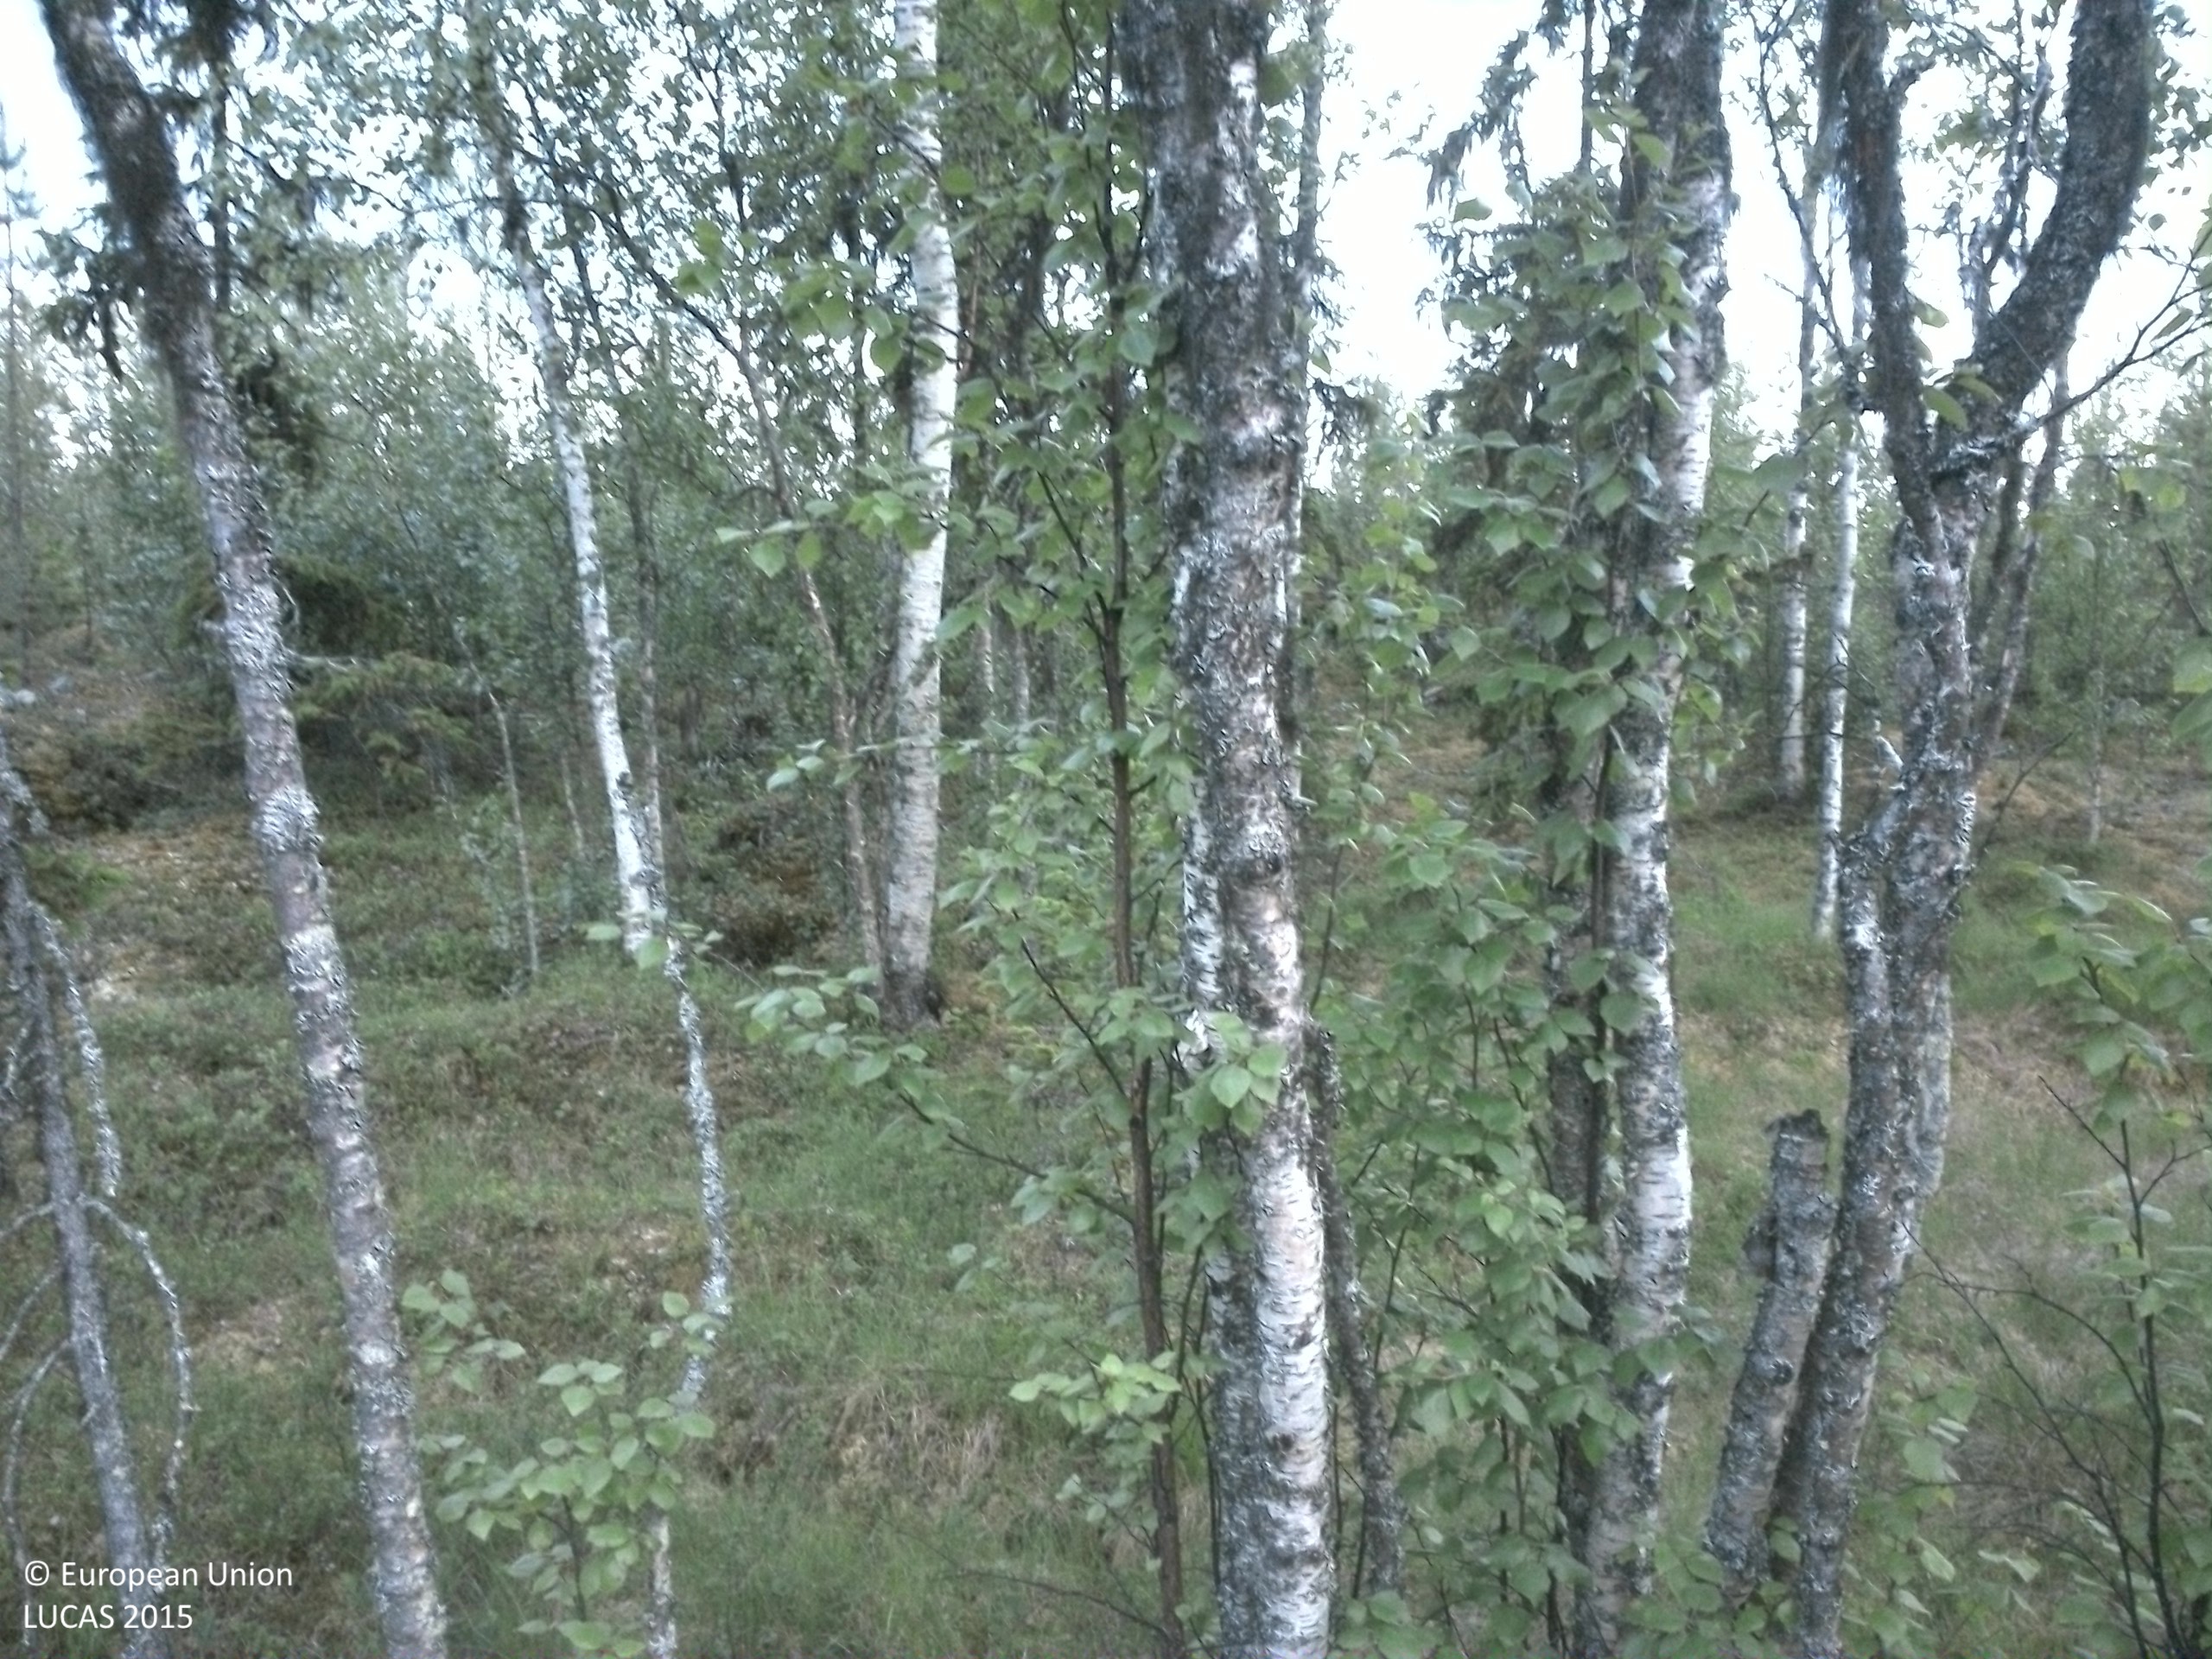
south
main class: Woodland
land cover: Pine dominated mixed woodland
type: boreal forest
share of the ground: 10 - 25 %
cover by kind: herbaceous plants 35 %, shrubs 25 %, coniferous forest trees 15 %, lichens and mosses 15 %, broadleaved forest trees 10 %
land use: Forestry
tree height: > 5 m
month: July
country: SE
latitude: 64.2824
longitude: 16.5166
